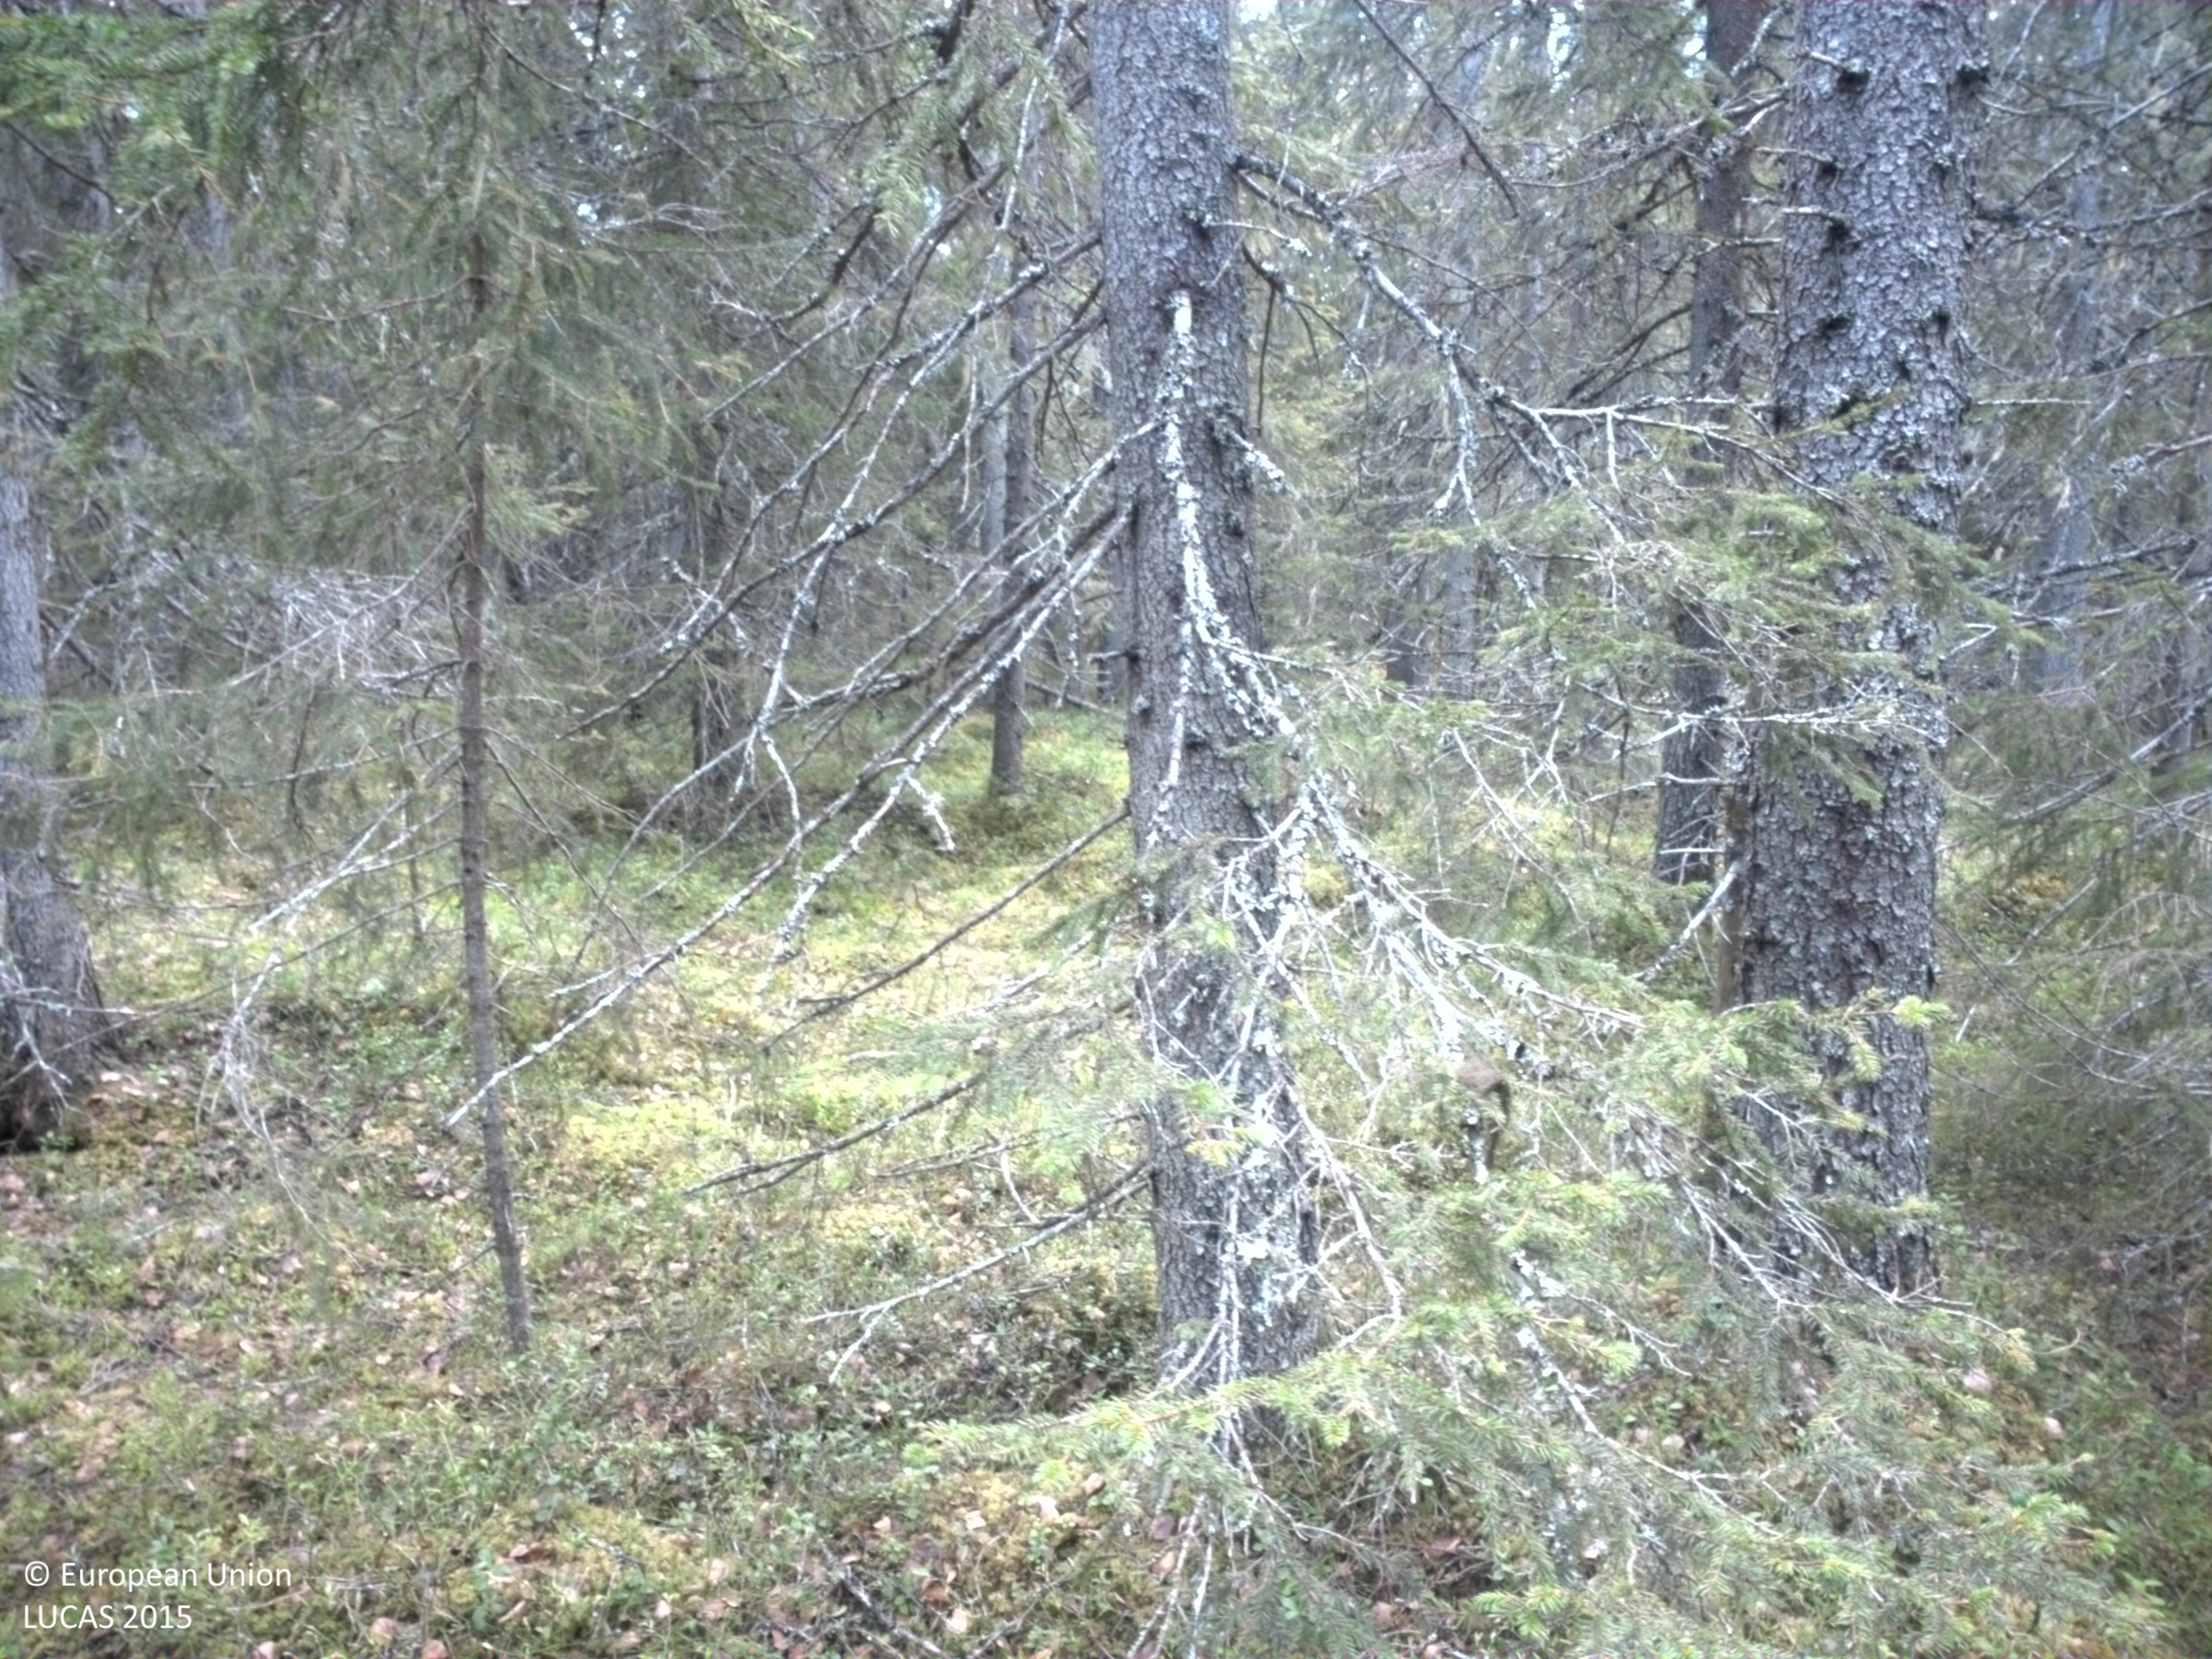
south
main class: Woodland
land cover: Spruce dominated mixed woodland
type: boreal forest
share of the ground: > 75 %
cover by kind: coniferous forest trees 60 %, broadleaved forest trees 20 %, shrubs 10 %, lichens and mosses 10 %
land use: Forestry
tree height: > 5 m
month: June
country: SE
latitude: 63.5179
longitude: 13.9396
